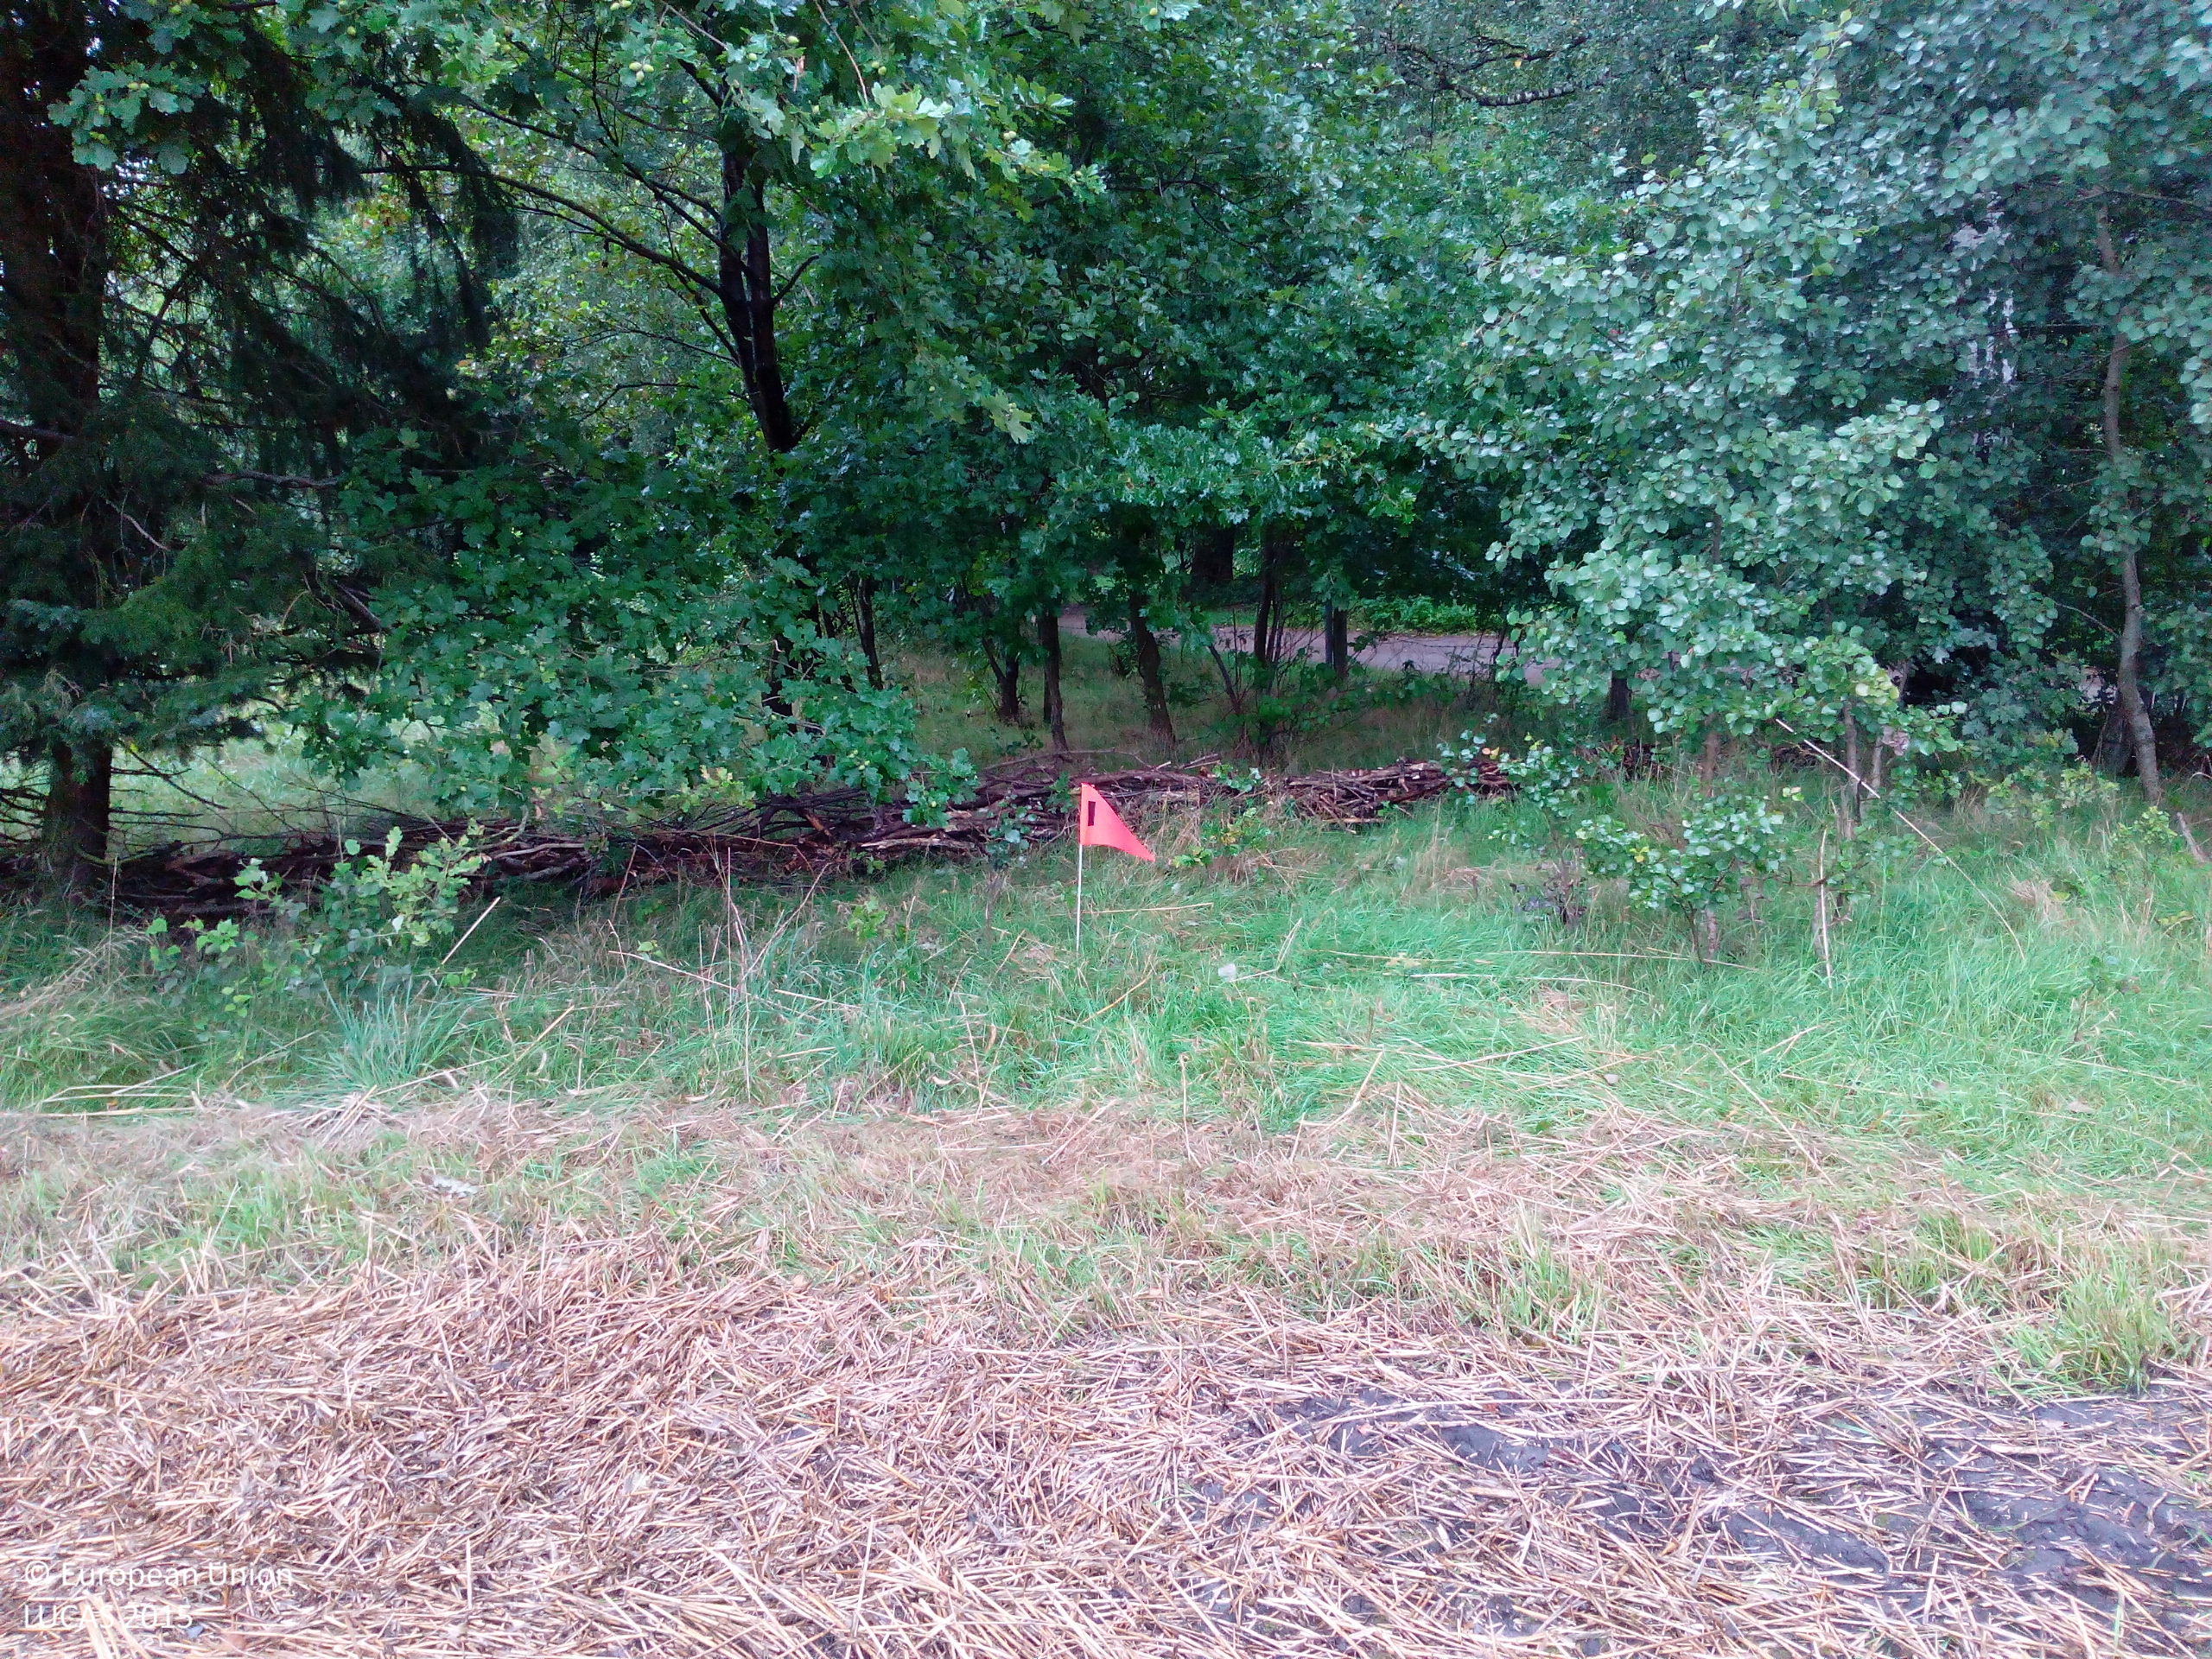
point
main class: Woodland
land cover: Broadleaved woodland
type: acidophilous oak and oak-birch forest
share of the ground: > 75 %
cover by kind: broadleaved forest trees 80 %, coniferous forest trees 10 %, herbaceous plants 10 %
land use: Agriculture (excluding fallow land and kitchen gardens)
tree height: > 5 m
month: August
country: DE
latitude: 53.7434
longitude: 9.9242
